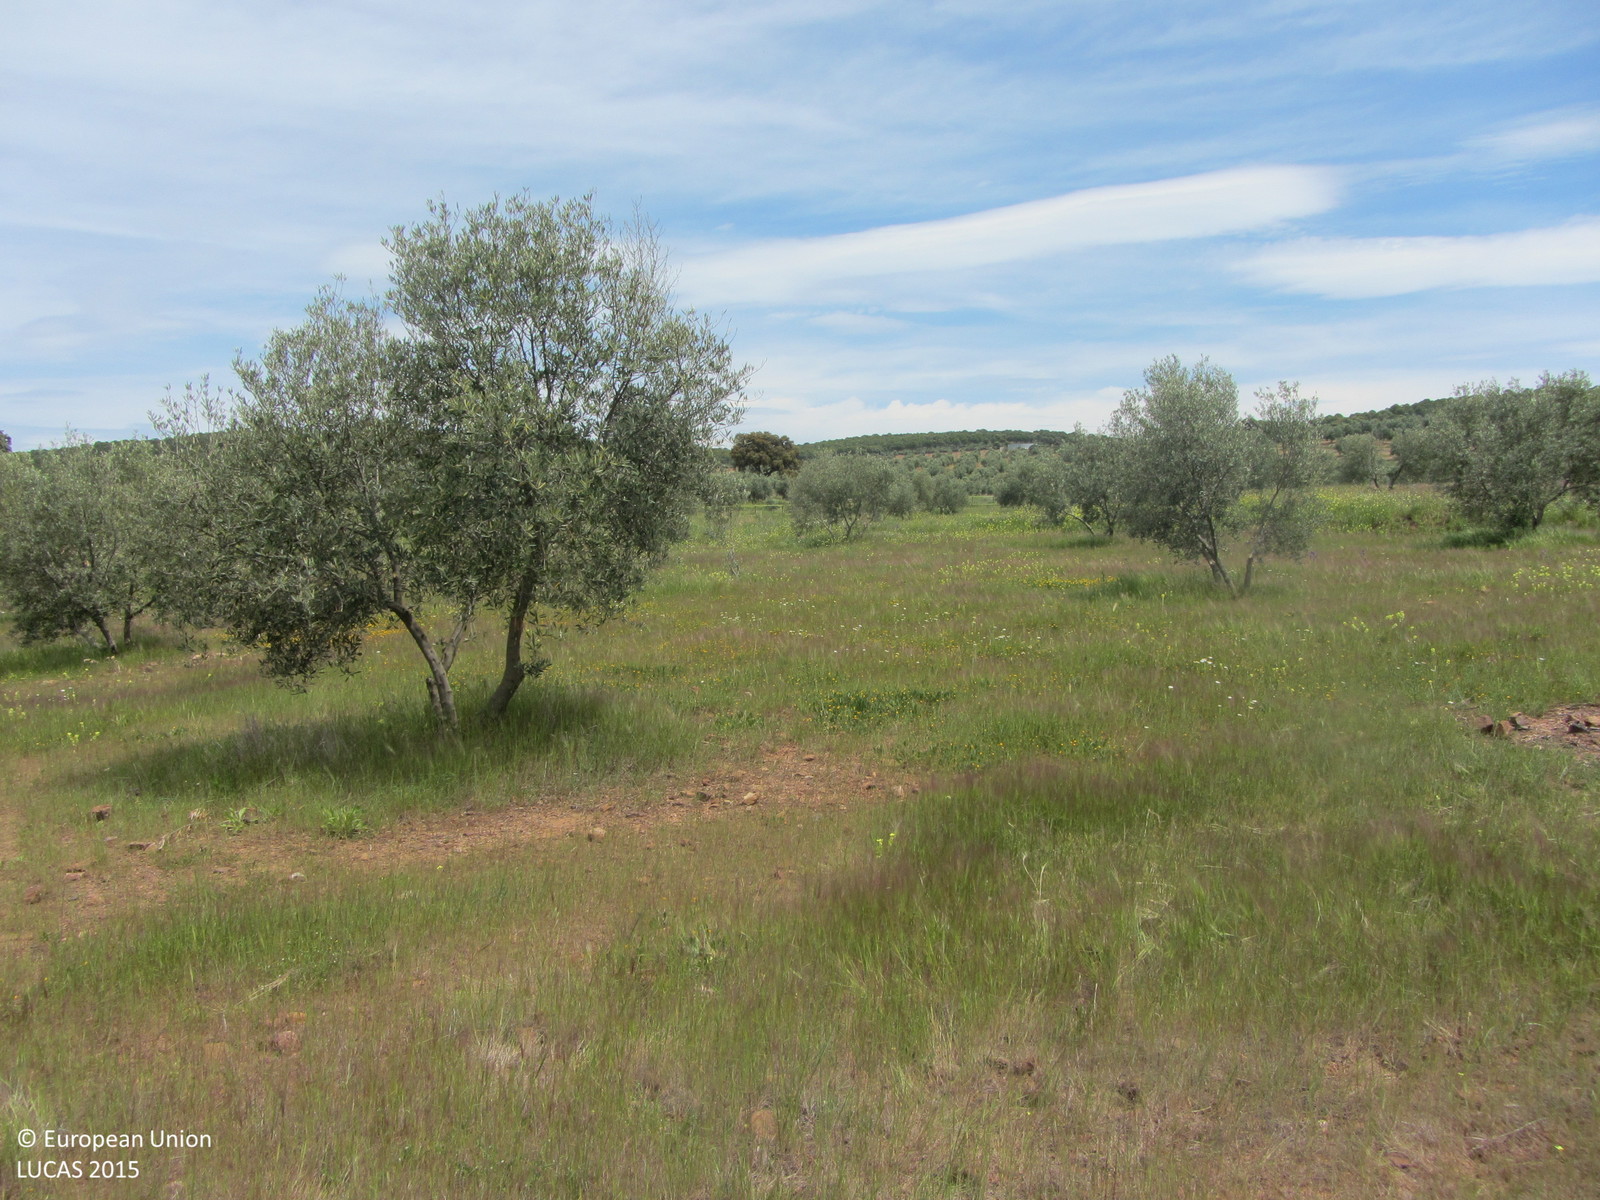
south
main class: Cropland
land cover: Olive groves
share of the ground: 10 - 25 %
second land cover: Spontaneously vegetated surfaces
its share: > 75 %
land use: Agriculture (excluding fallow land and kitchen gardens)
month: May
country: ES
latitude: 38.3559
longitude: -2.9898
